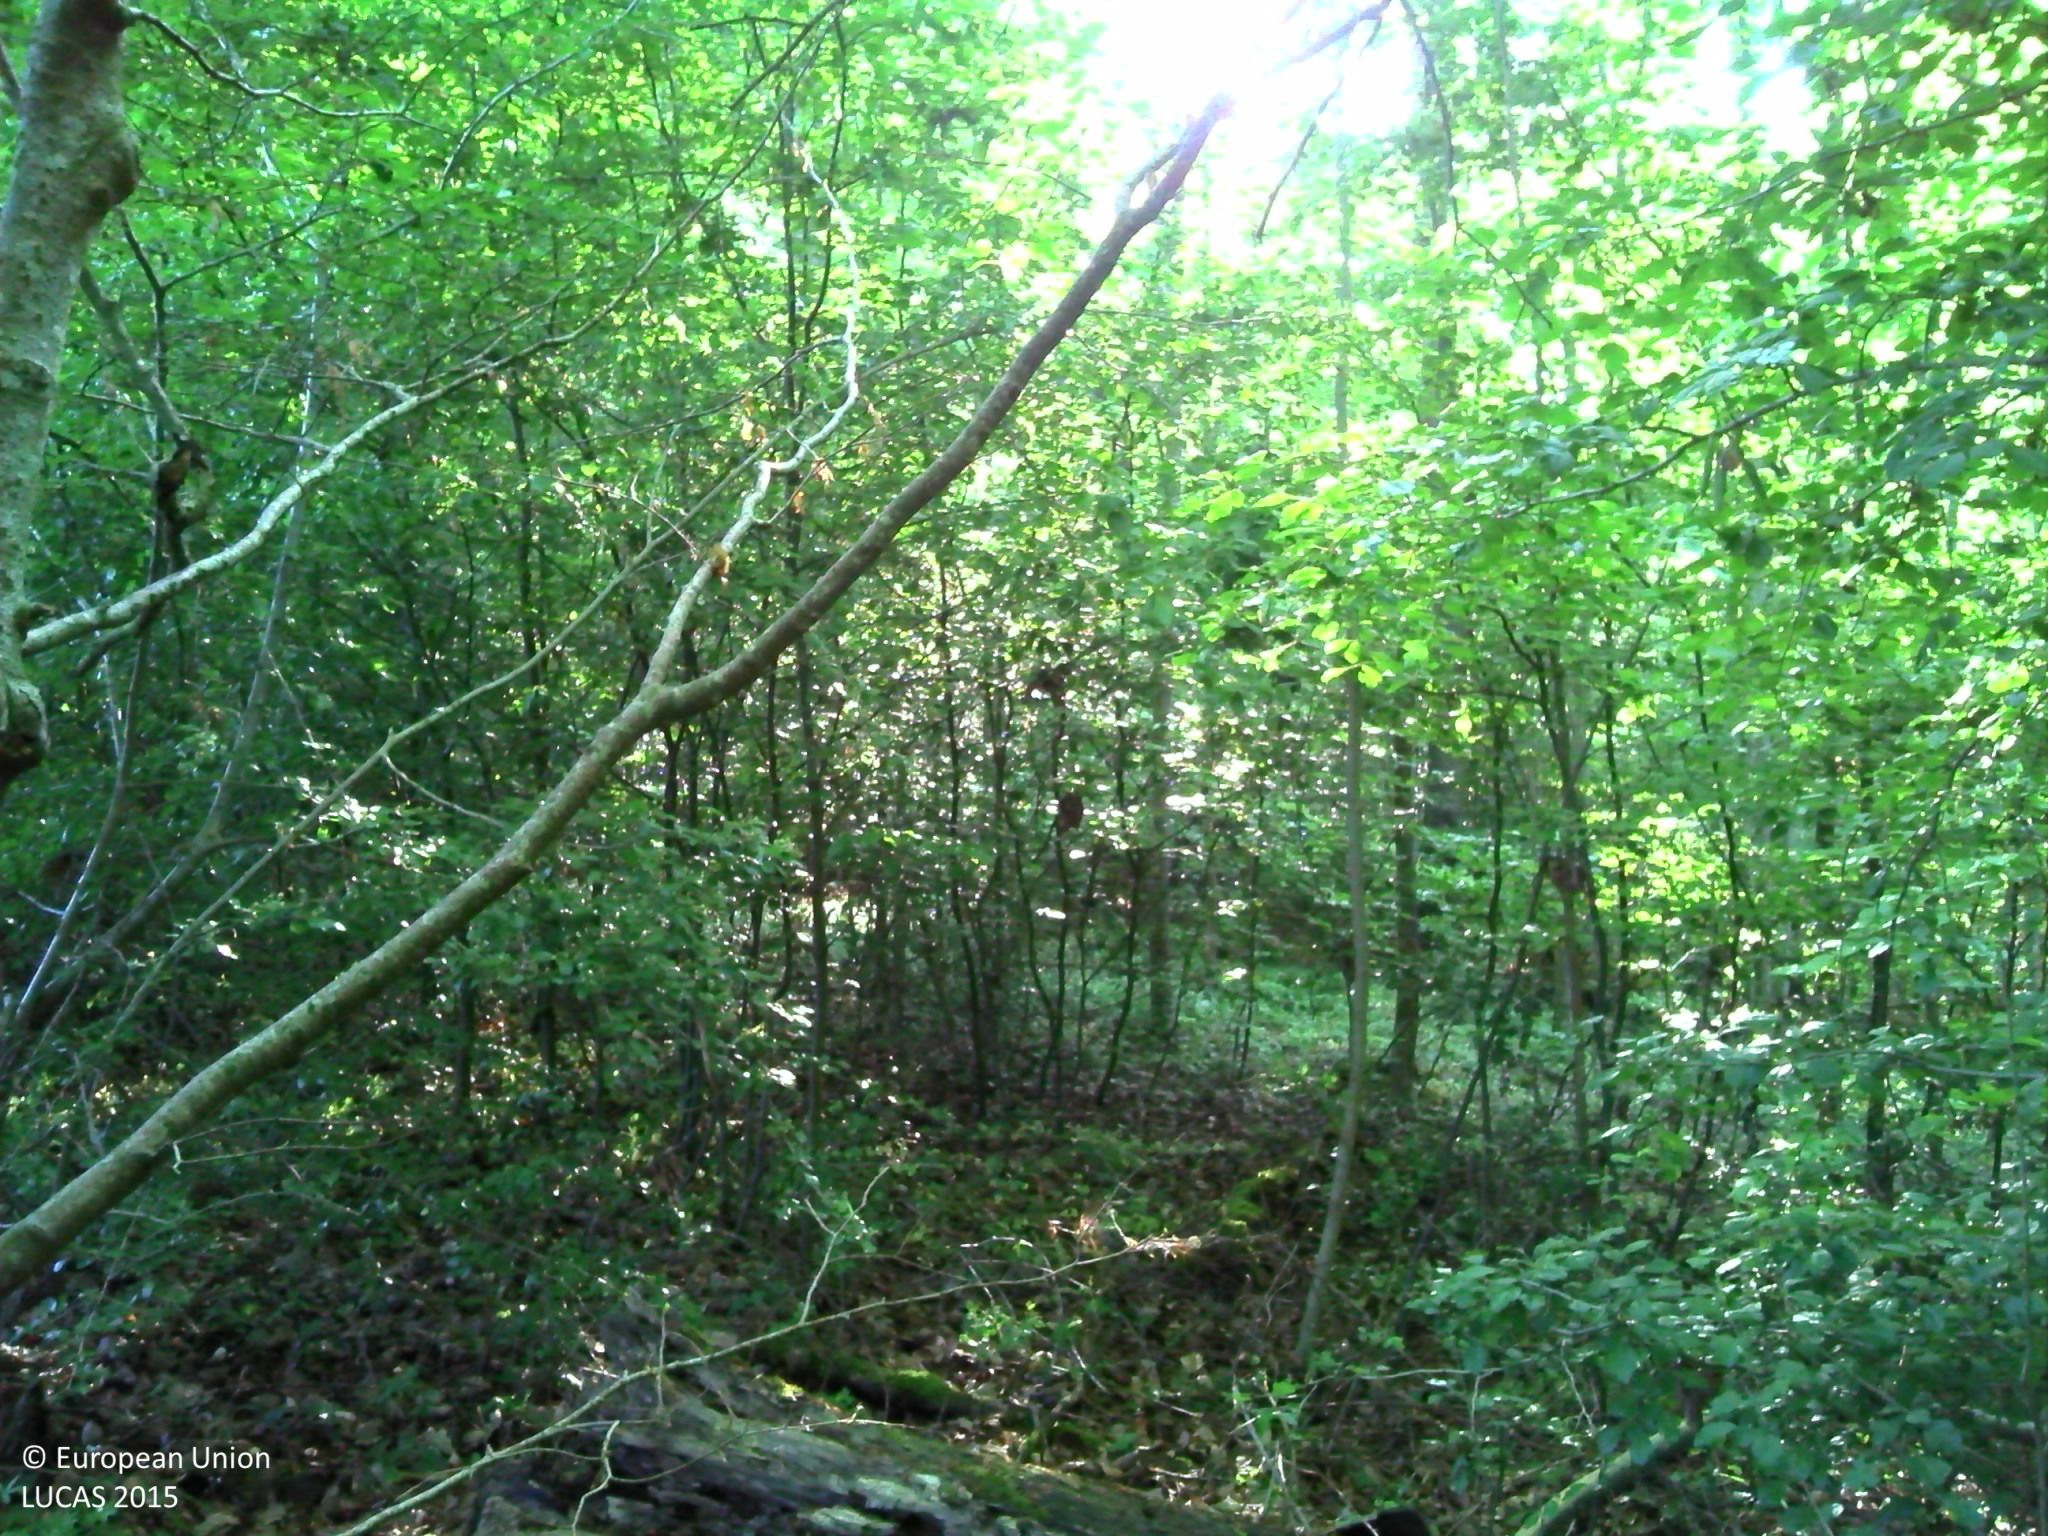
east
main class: Woodland
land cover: Broadleaved woodland
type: mesophytic deciduous forest
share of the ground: > 75 %
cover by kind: broadleaved forest trees 90 %, herbaceous plants 5 %, lichens and mosses 5 %
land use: Forestry
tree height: > 5 m
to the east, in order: Broadleaved woodland; Rivers and streams; Broadleaved woodland
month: May
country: LU
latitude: 49.6409
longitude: 6.3854
